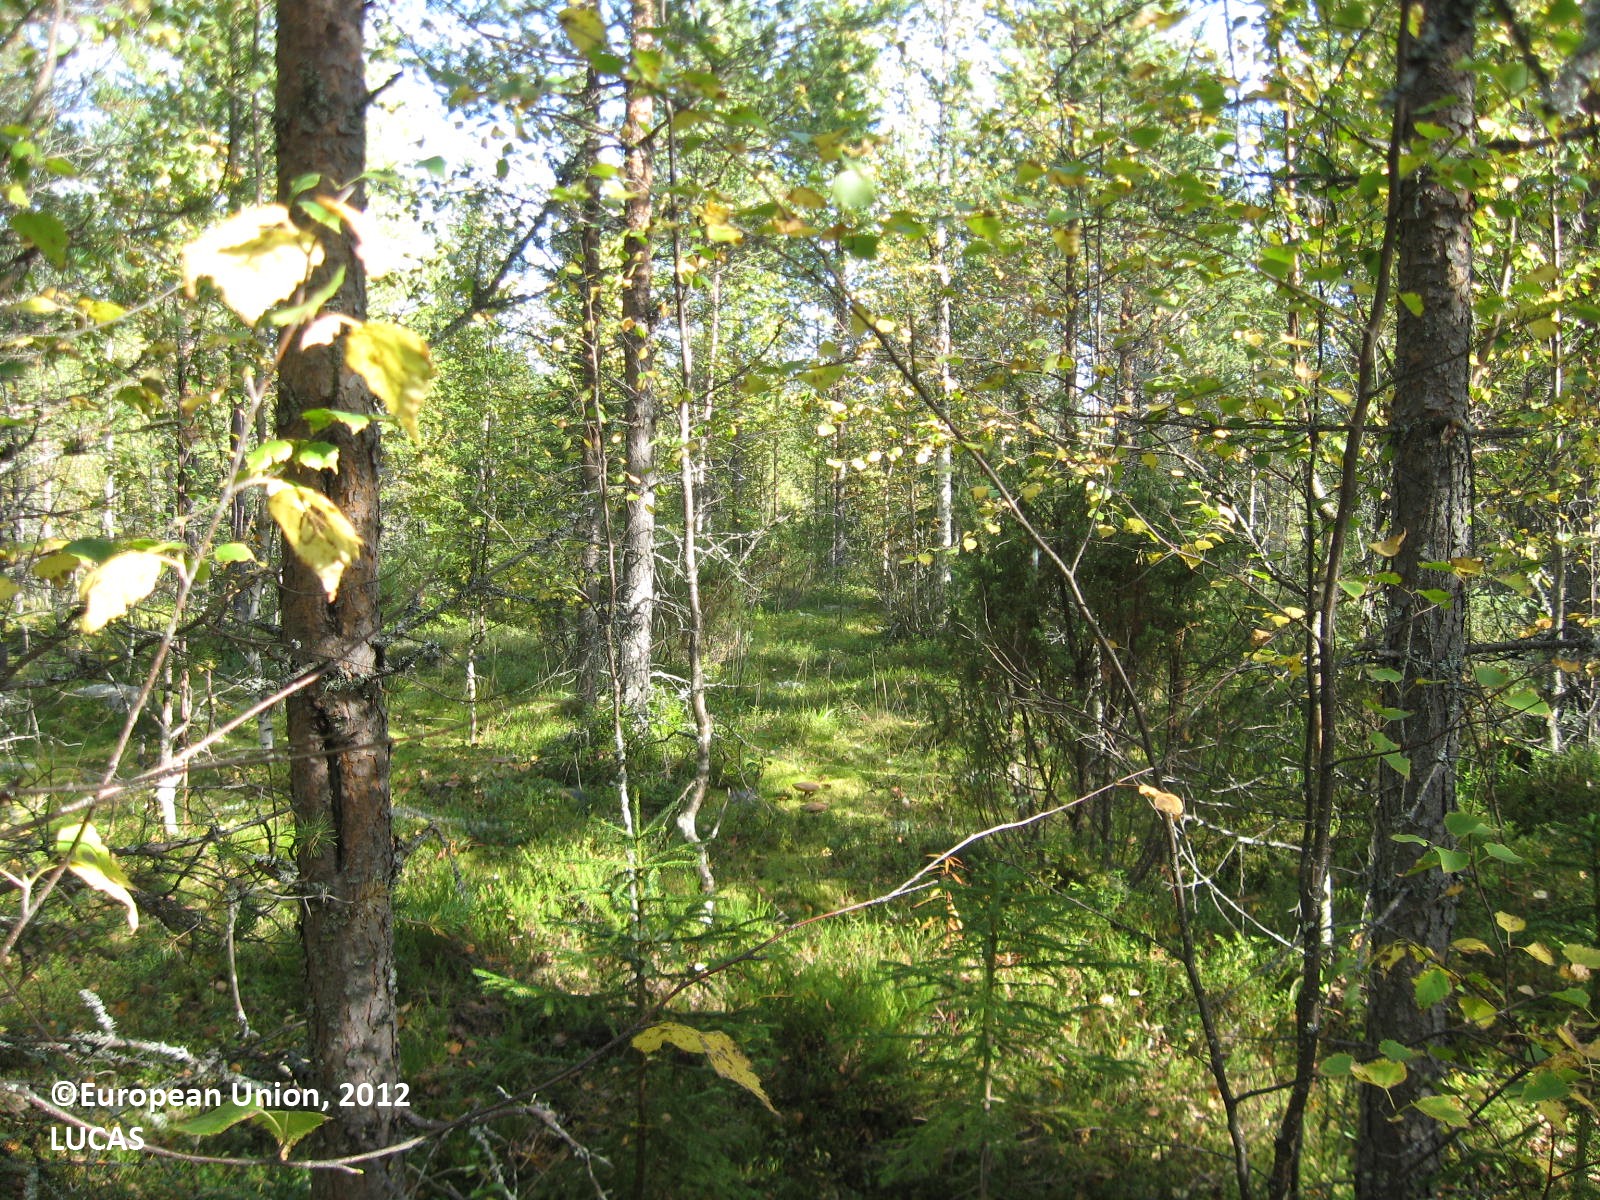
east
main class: Woodland
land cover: Other mixed woodland
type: boreal forest
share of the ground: > 75 %
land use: Forestry
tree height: > 5 m
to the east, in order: Other mixed woodland; Spruce dominated mixed woodland; Ditches and canals; Pine dominated mixed woodland
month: August
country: FI
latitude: 63.8858
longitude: 28.7014
